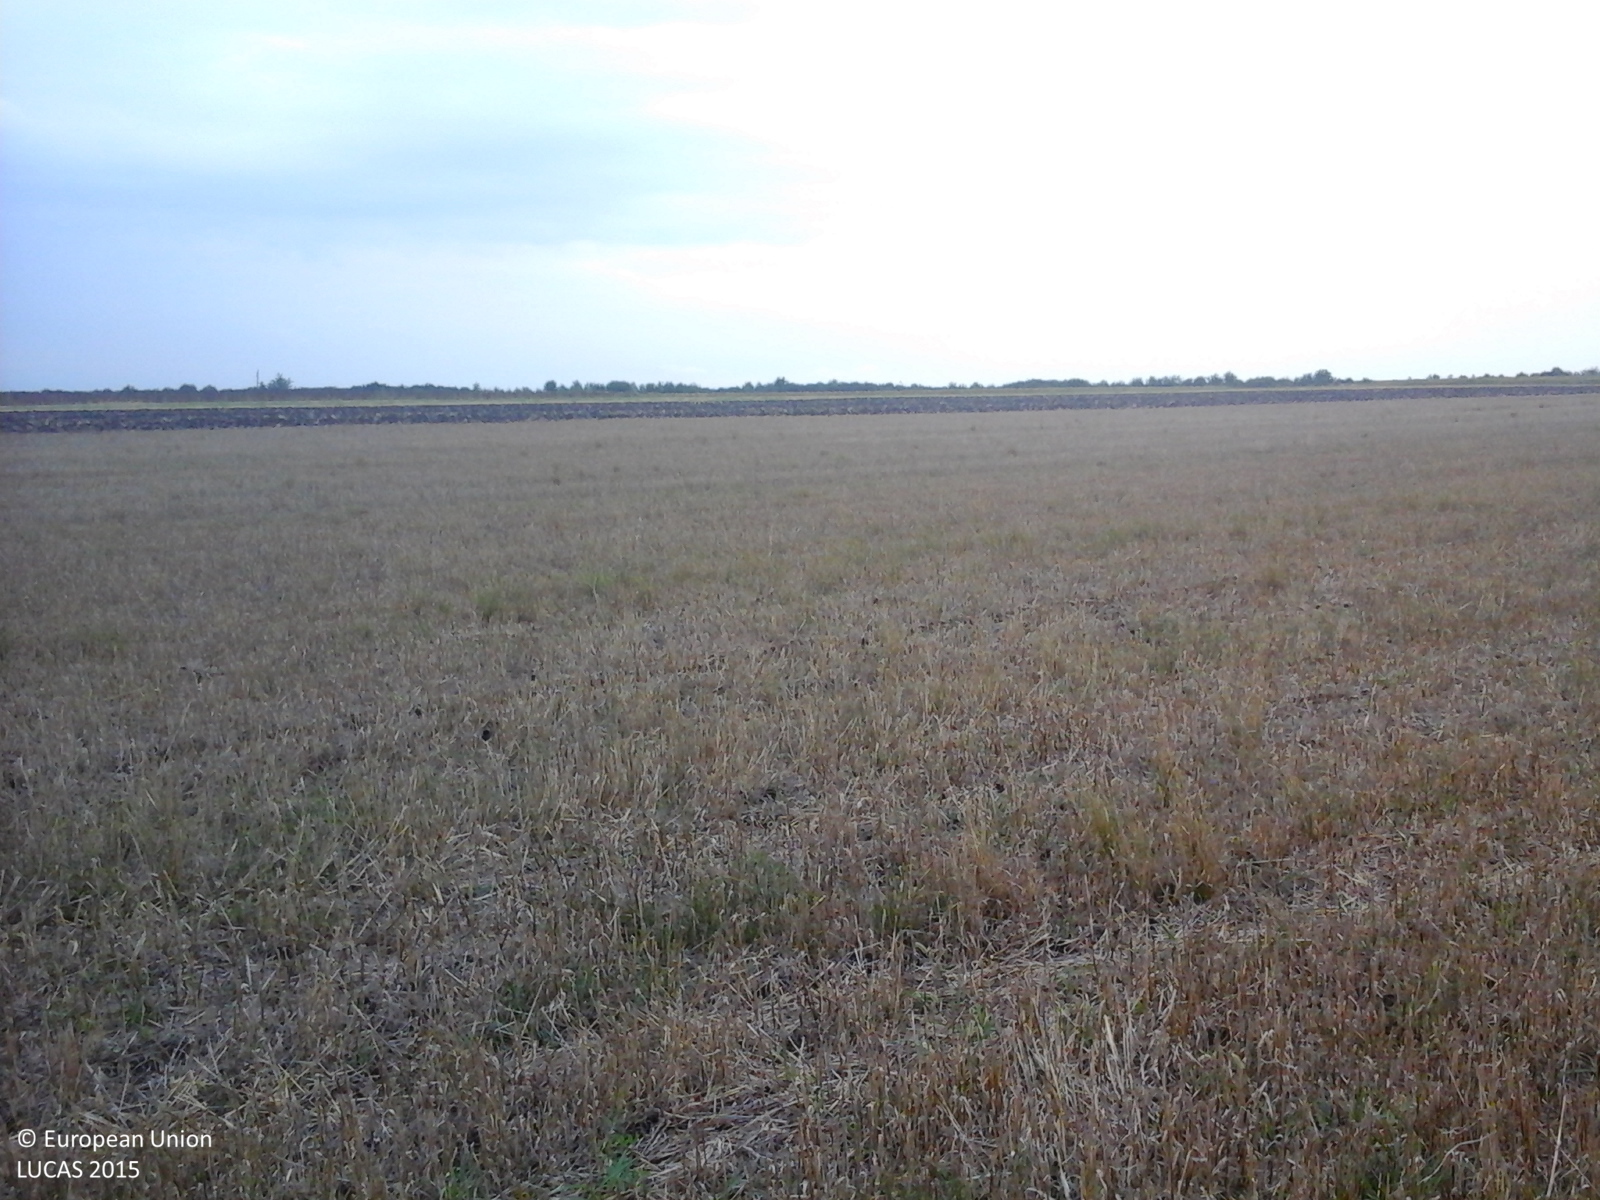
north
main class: Cropland
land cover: Durum wheat
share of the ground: 25 - 50 %
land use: Agriculture (excluding fallow land and kitchen gardens)
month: August
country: RO
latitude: 46.0325
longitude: 20.5024
